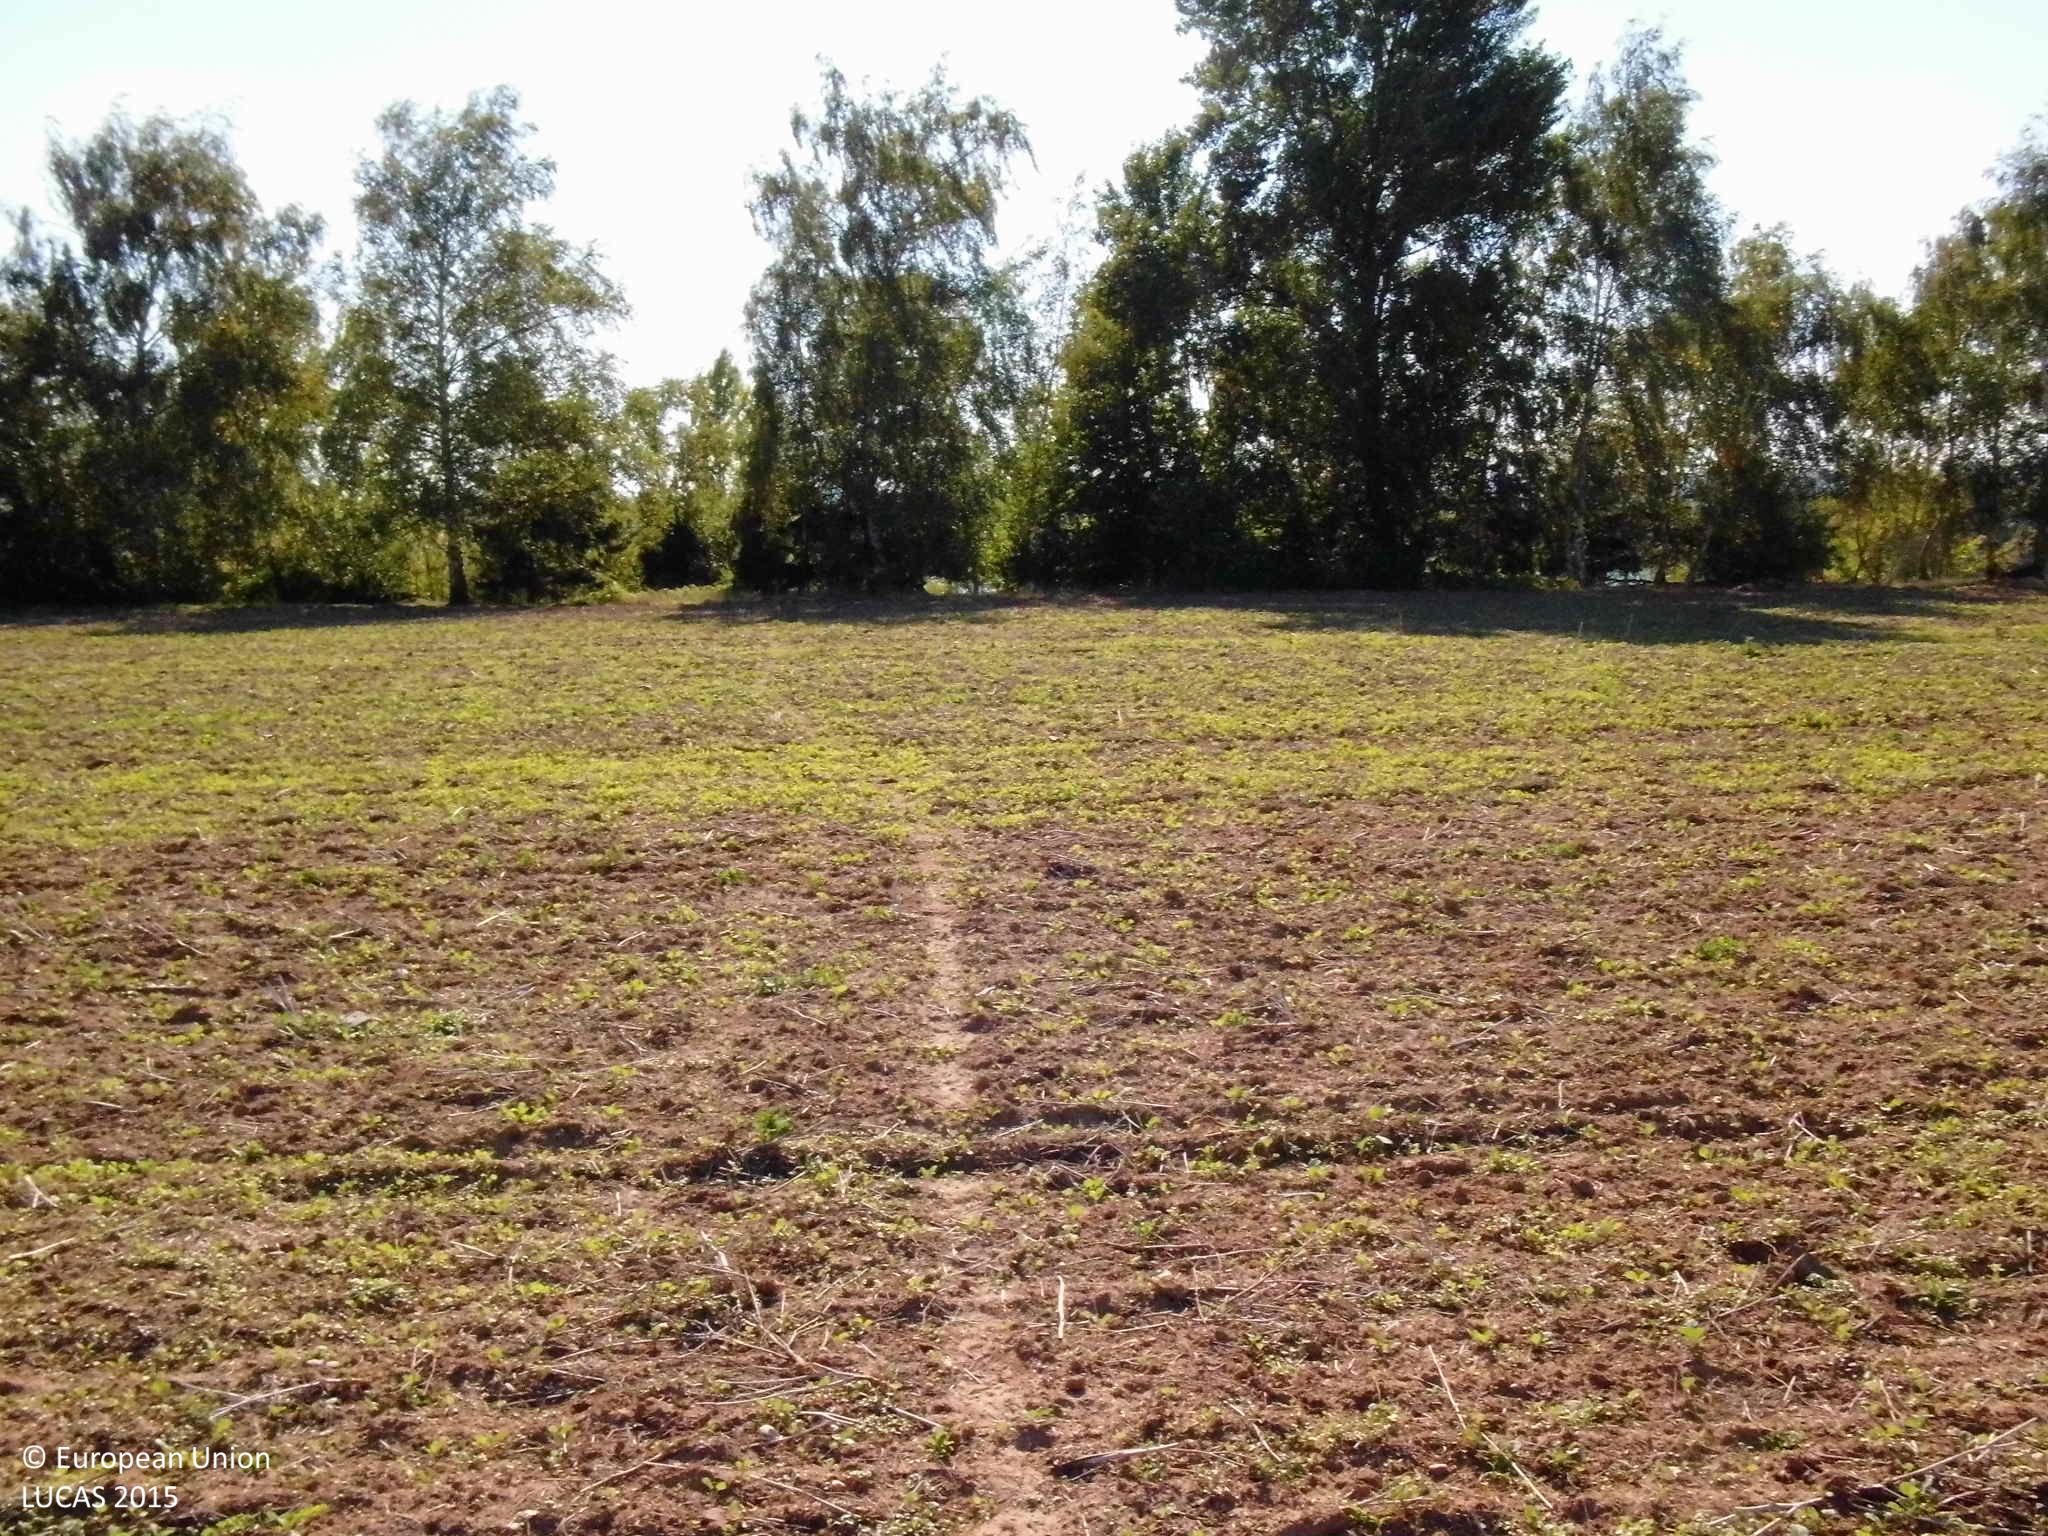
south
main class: Cropland
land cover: Rape and turnip rape
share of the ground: < 10 %
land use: Agriculture (excluding fallow land and kitchen gardens)
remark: Harvested field
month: October
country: DE
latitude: 50.4269
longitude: 7.5087
